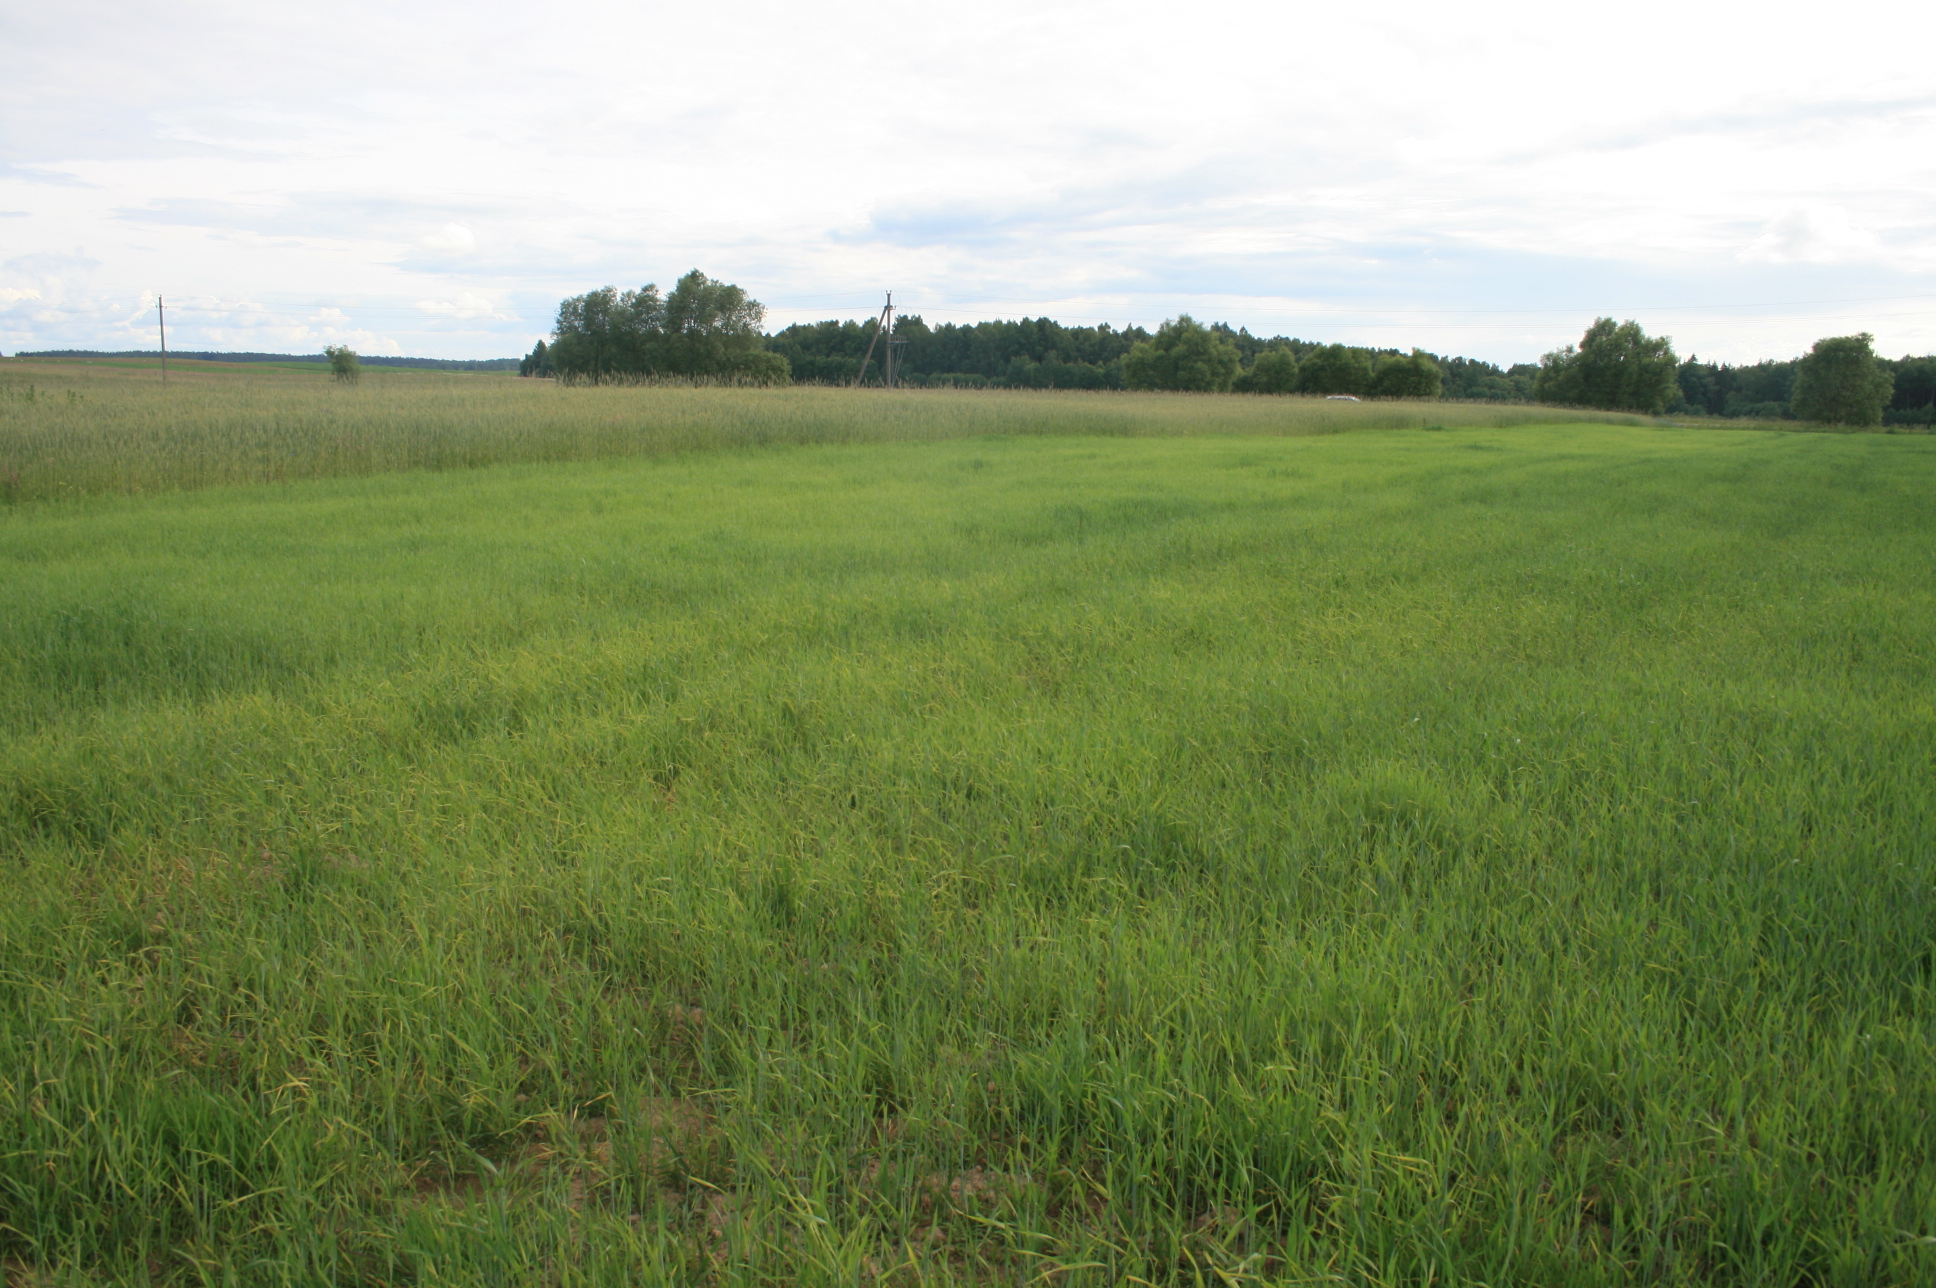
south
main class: Cropland
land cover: Barley
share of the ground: > 75 %
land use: Agriculture (excluding fallow land and kitchen gardens)
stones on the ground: < 10 %
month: June
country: LT
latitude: 55.1052
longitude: 22.0775
